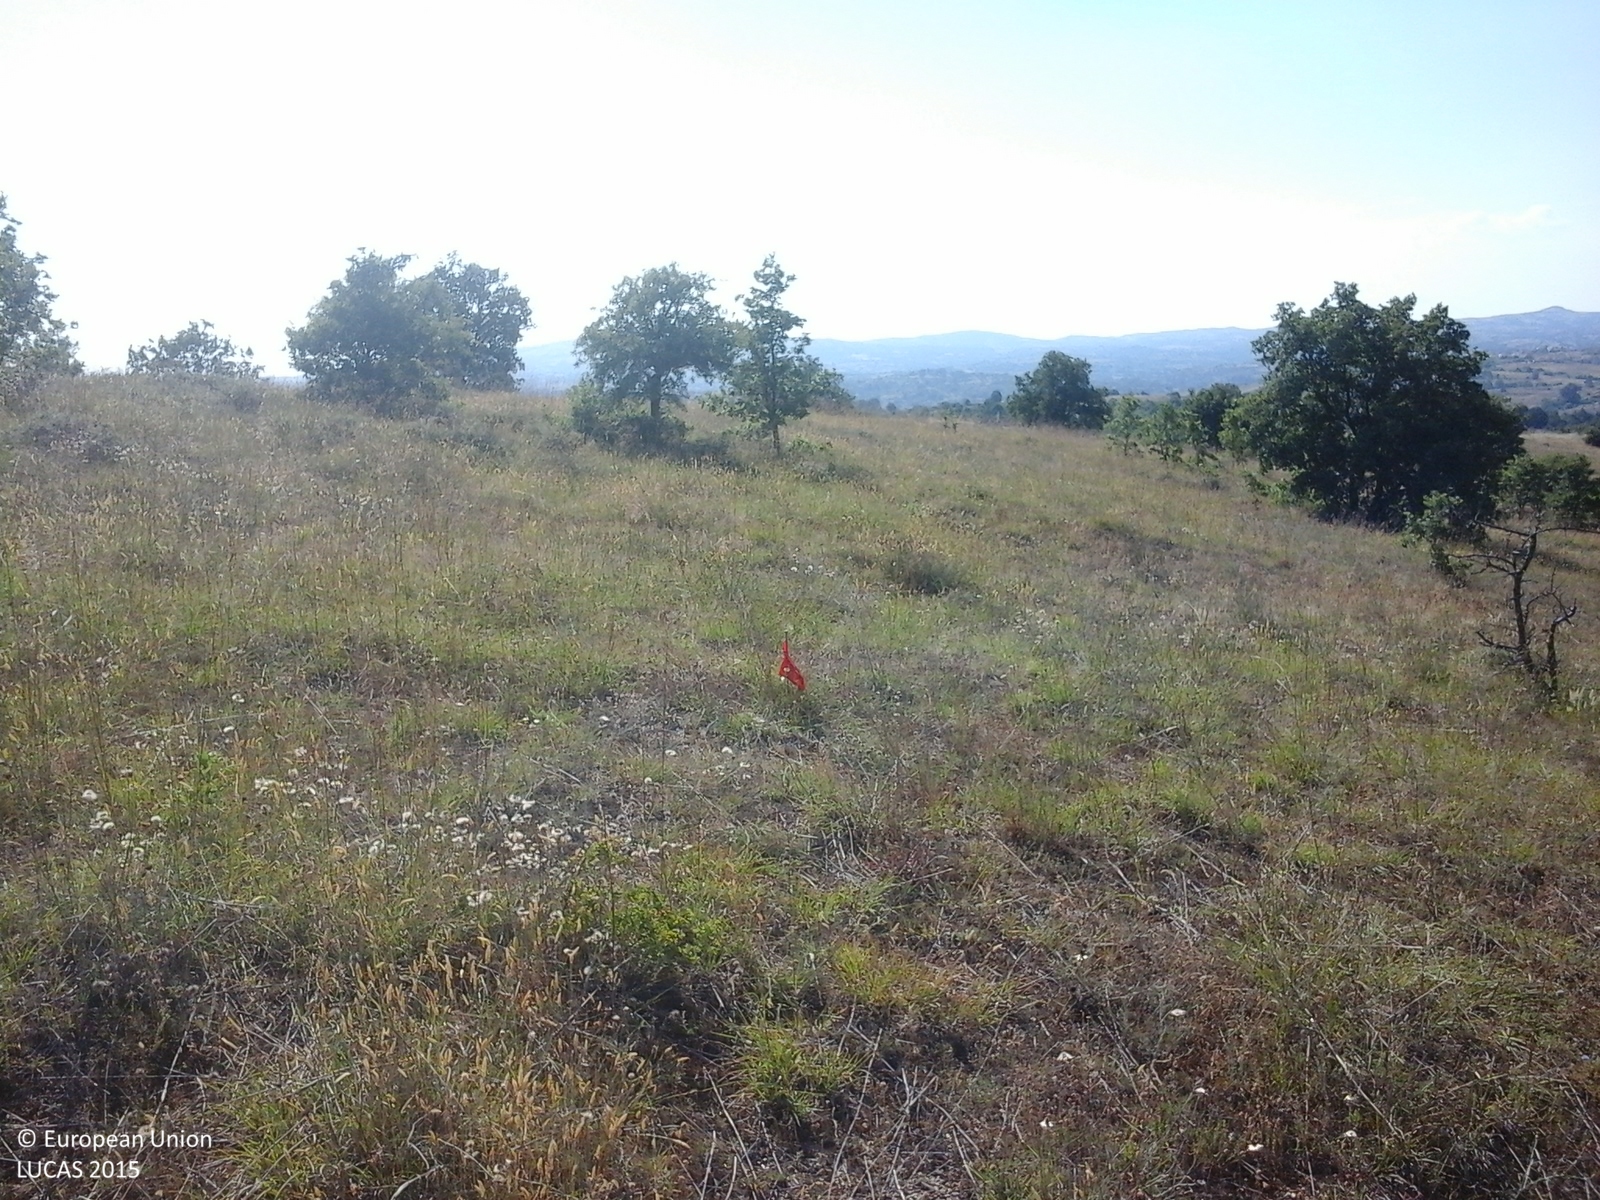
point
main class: Grassland
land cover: Grassland with sparse tree/shrub cover
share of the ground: > 75 %
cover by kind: herbaceous plants 90 %, broadleaved forest trees 5 %, shrubs 5 %
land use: Semi-natural and natural areas not in use
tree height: < 5 m
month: June
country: GR
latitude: 40.9079
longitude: 23.2032
